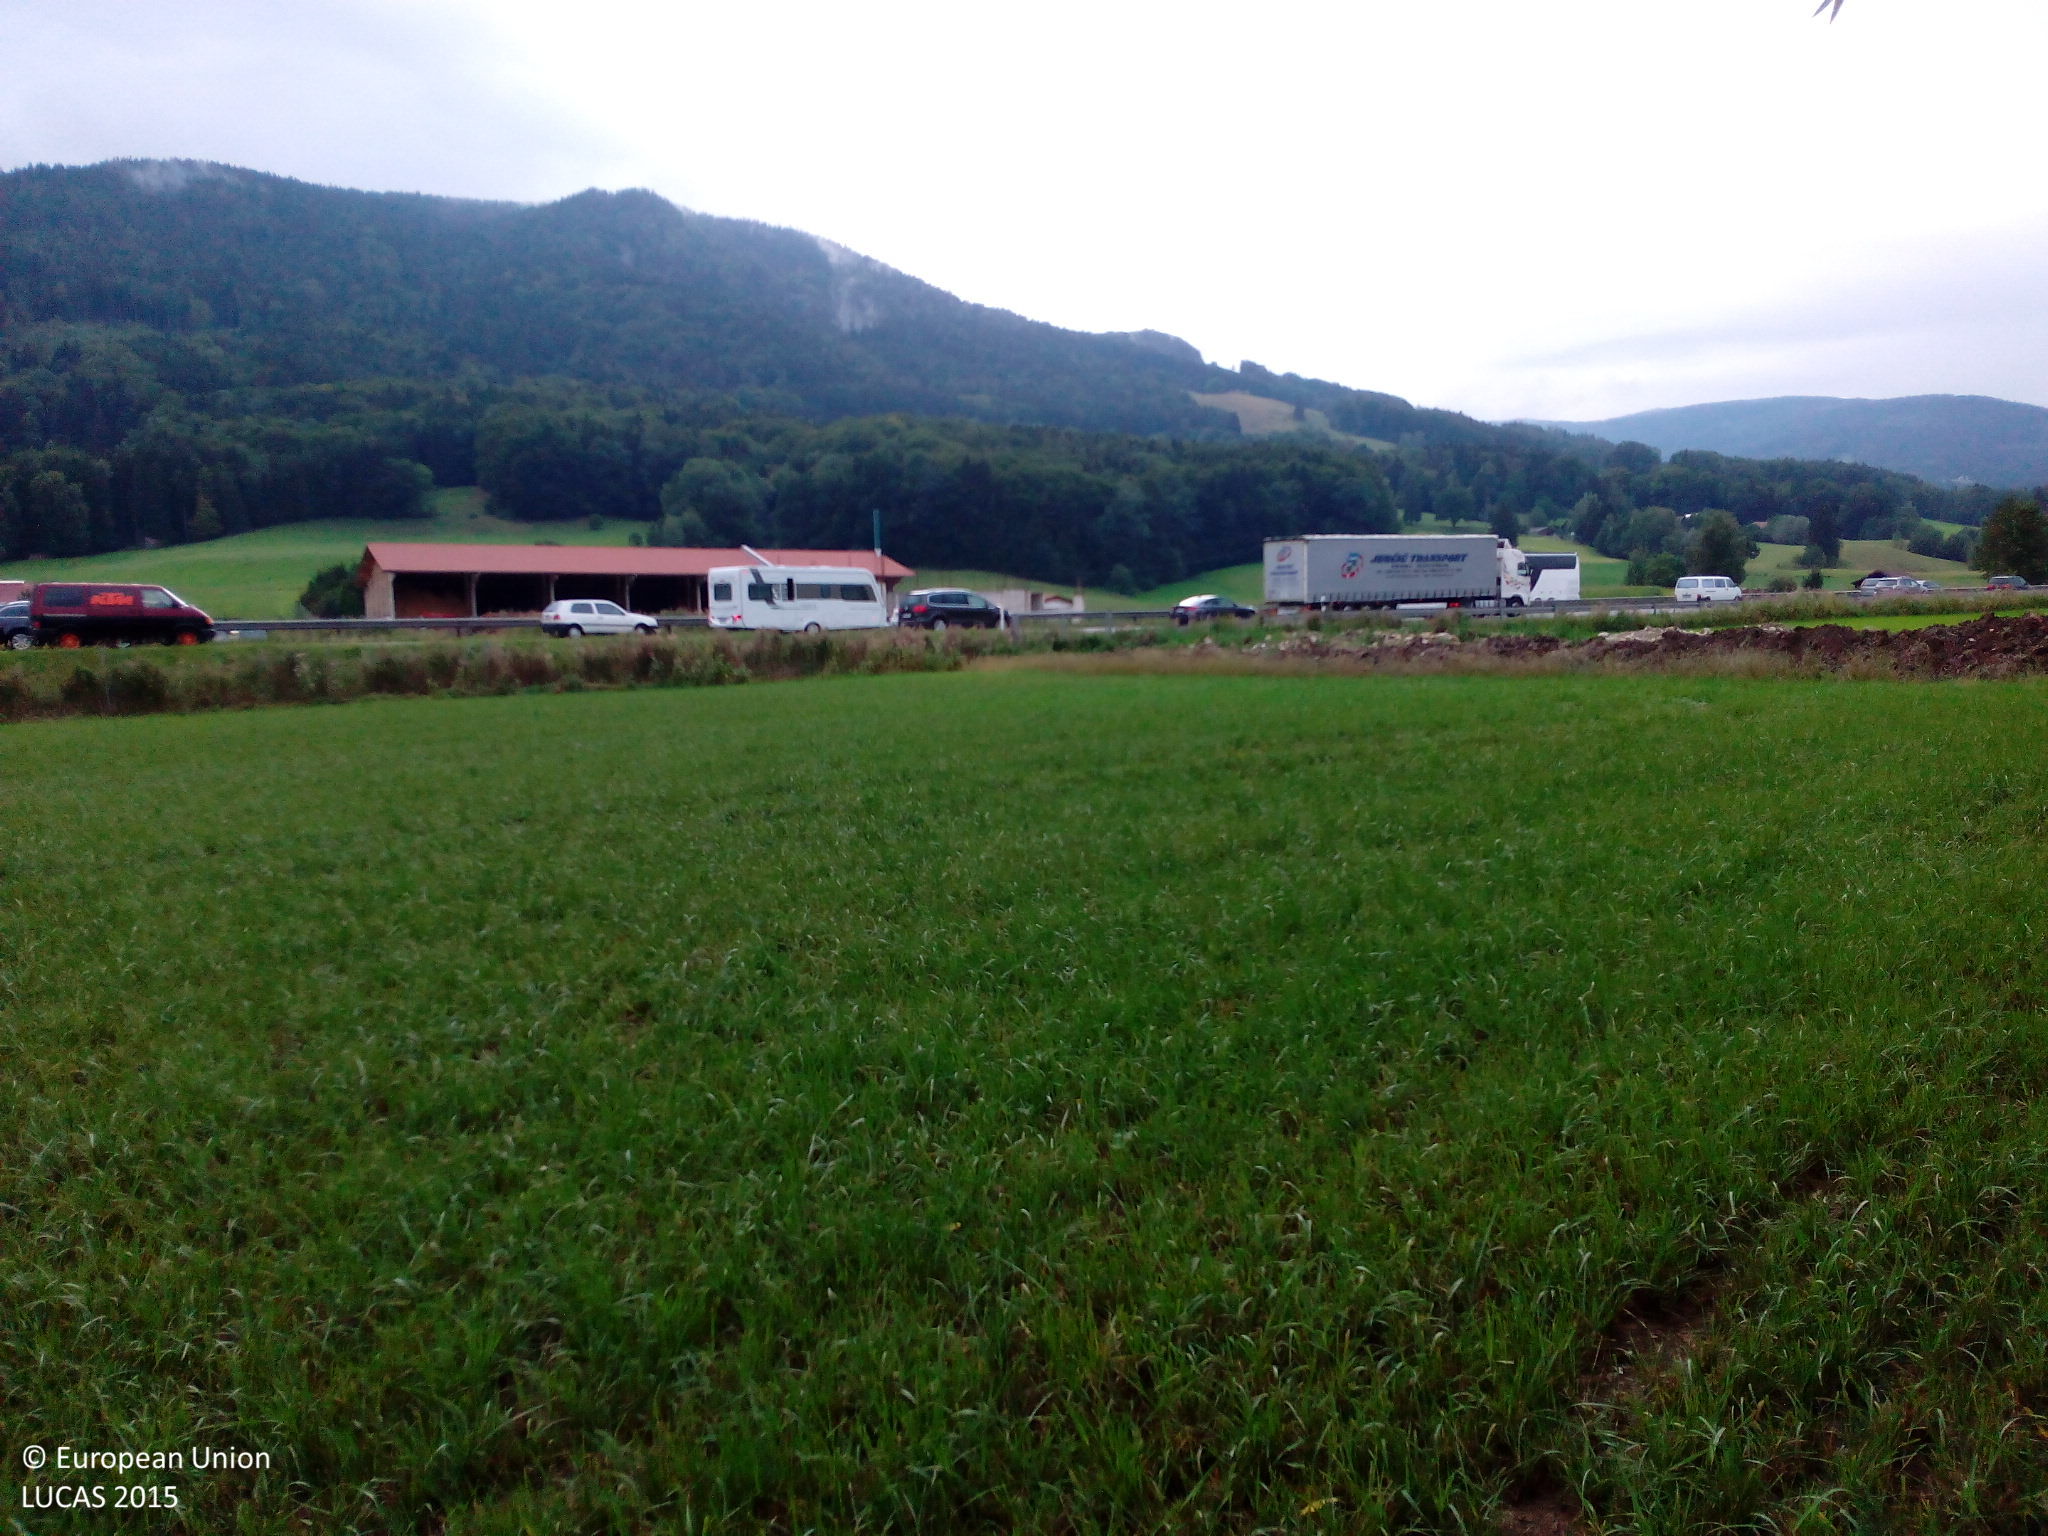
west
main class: Cropland
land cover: Temporary grasslands
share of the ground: 50 - 75 %
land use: Agriculture (excluding fallow land and kitchen gardens)
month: August
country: DE
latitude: 47.7901
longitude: 12.8686
